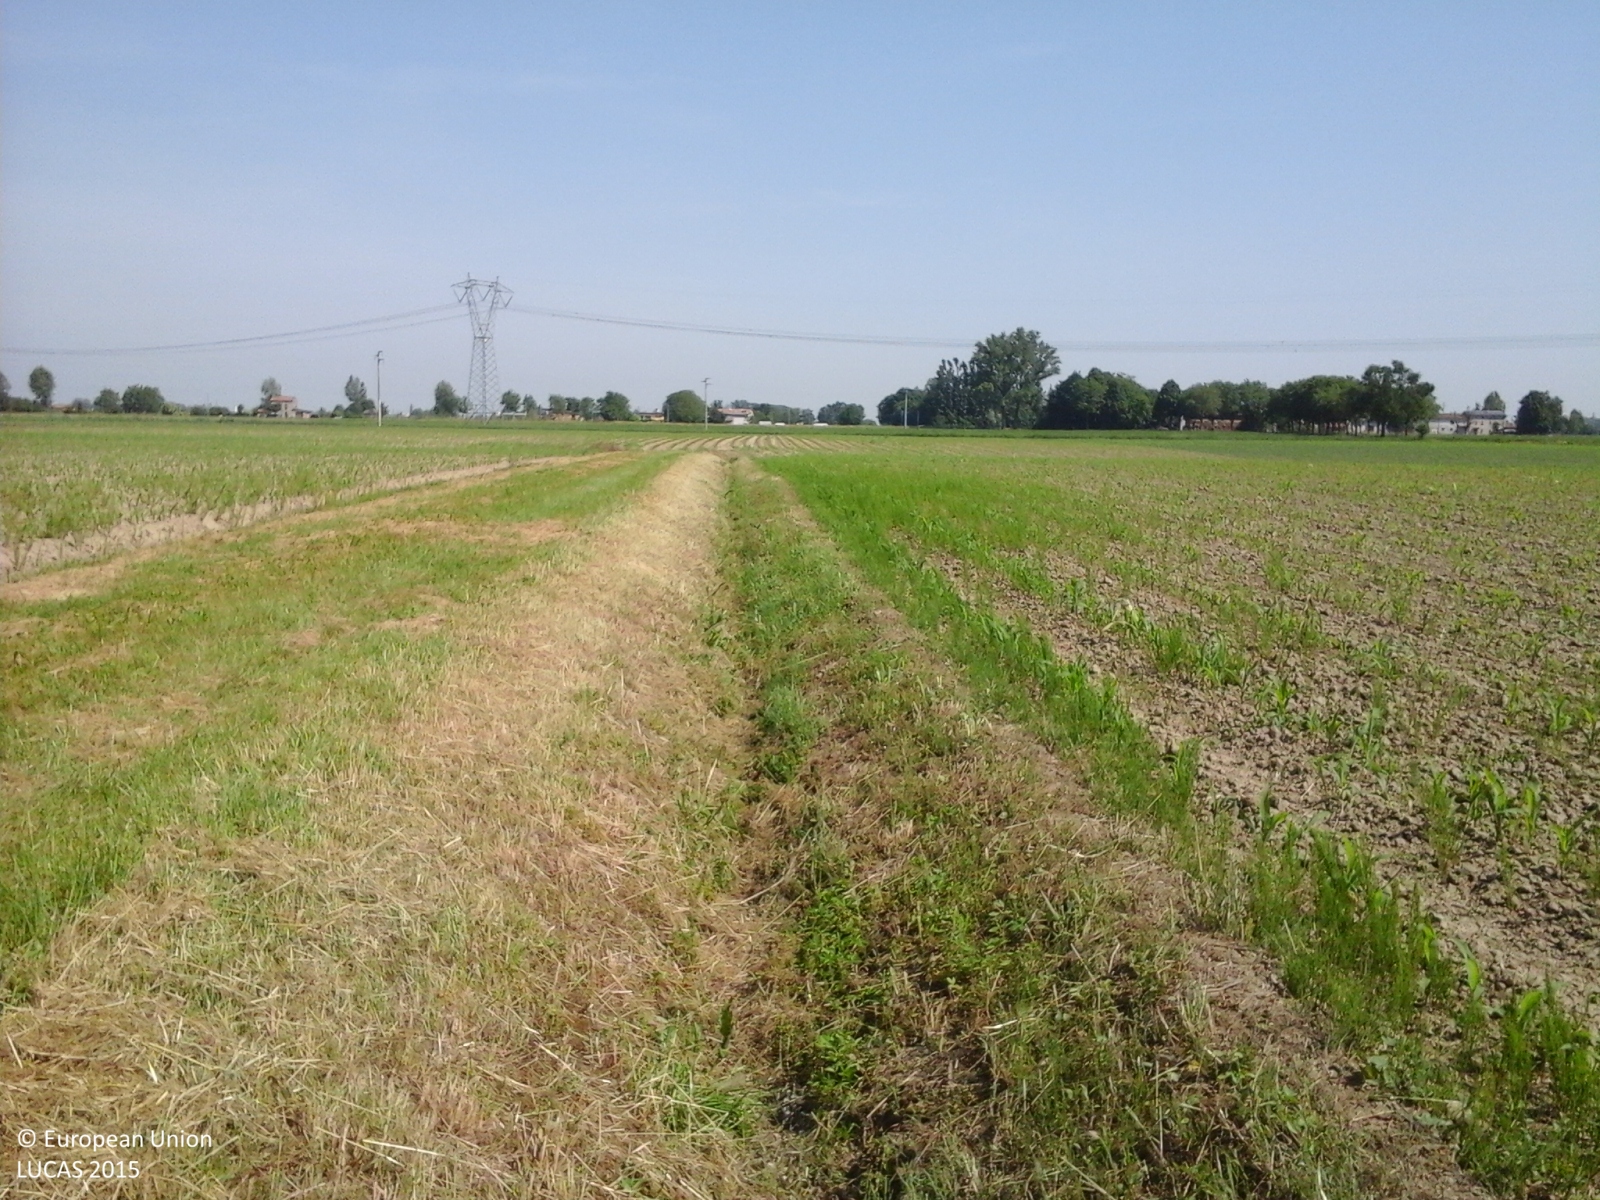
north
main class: Cropland
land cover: Maize
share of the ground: 10 - 25 %
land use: Agriculture (excluding fallow land and kitchen gardens)
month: May
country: IT
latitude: 44.9253
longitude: 10.6954
